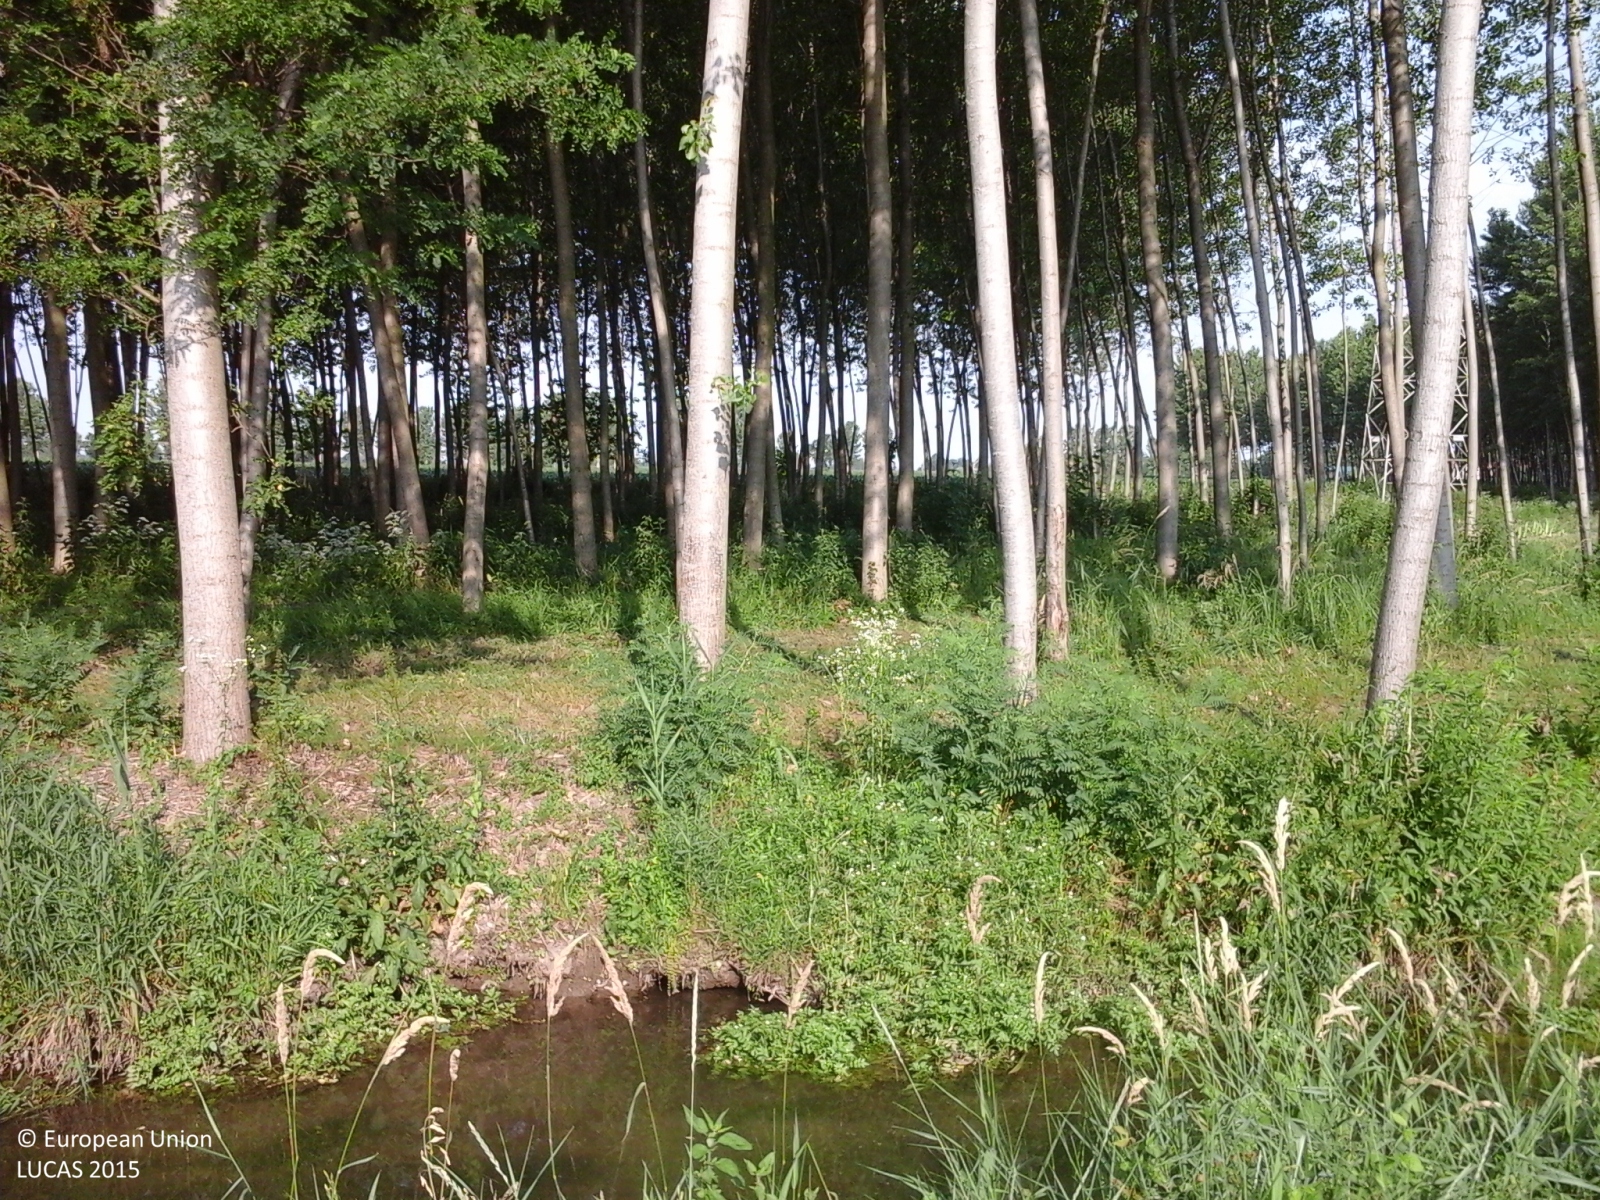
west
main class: Cropland
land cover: Temporary grasslands
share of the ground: > 75 %
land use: Agriculture (excluding fallow land and kitchen gardens)
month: June
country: IT
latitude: 45.3234
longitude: 9.6052
